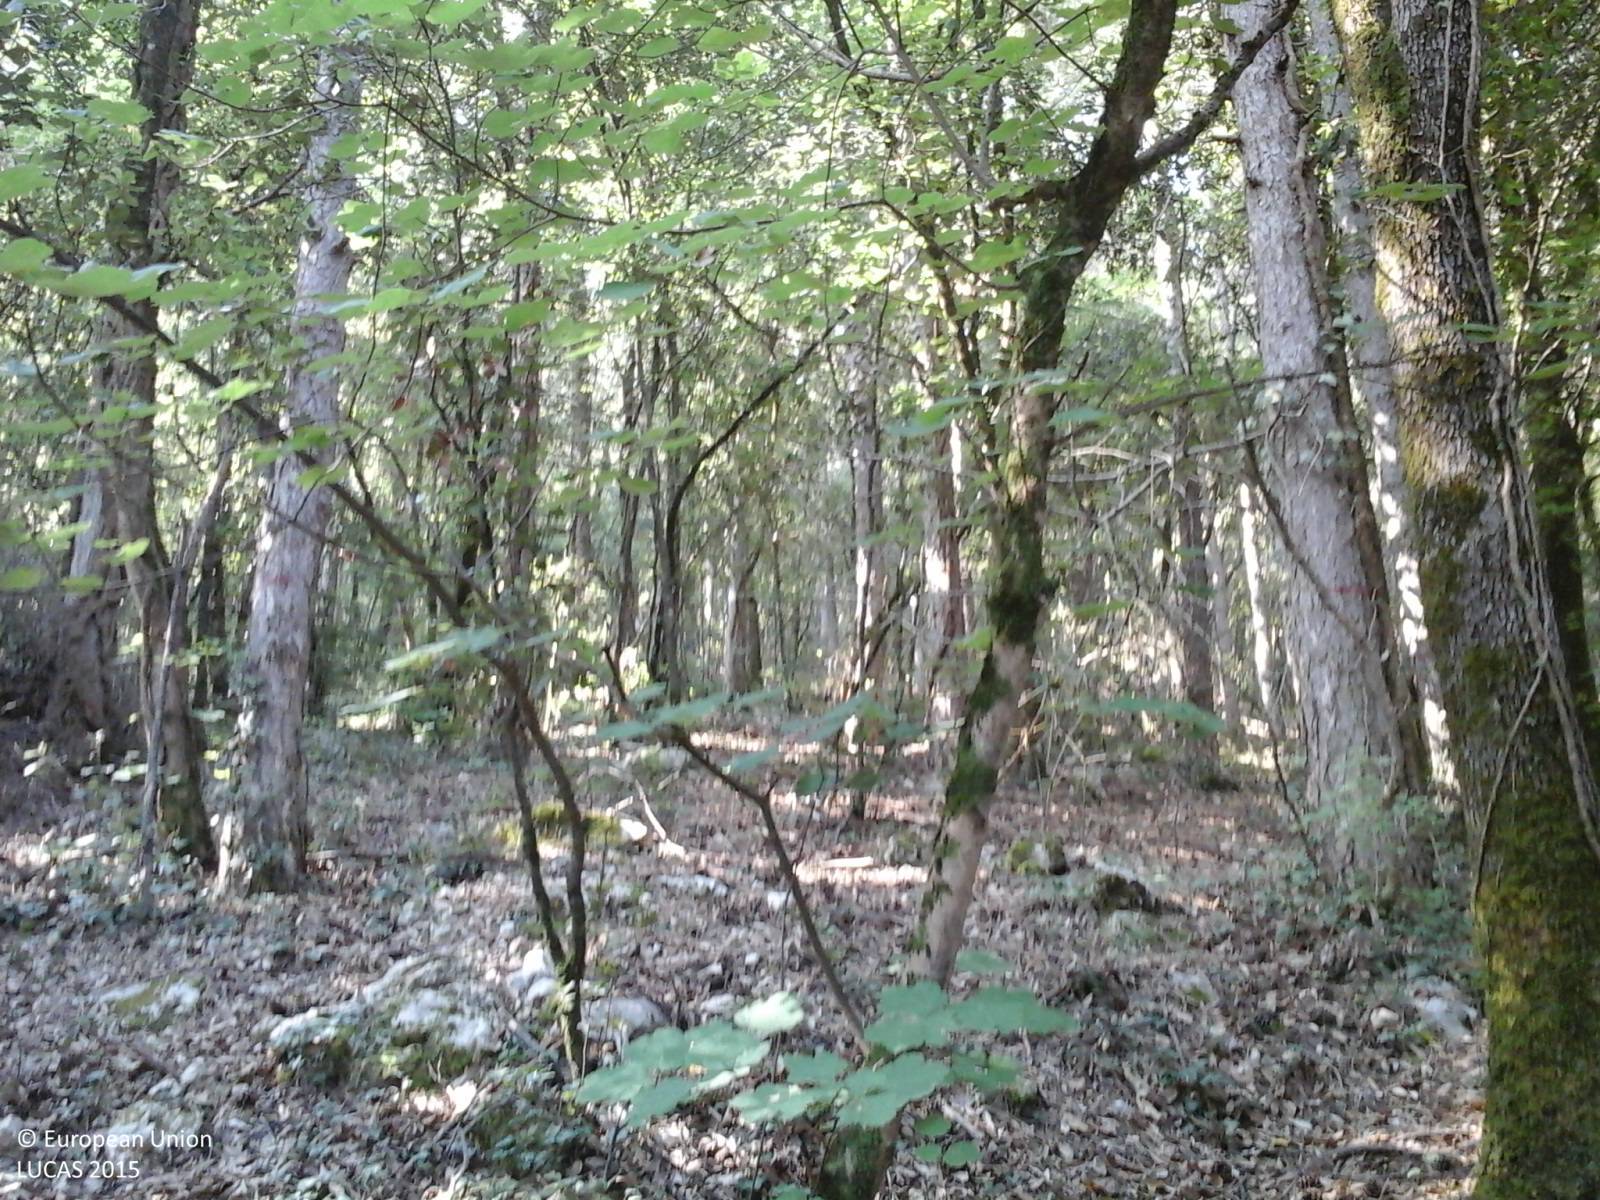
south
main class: Woodland
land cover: Other mixed woodland
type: coniferous forest of the mediterranean region
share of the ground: > 75 %
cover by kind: coniferous forest trees 60 %, broadleaved forest trees 40 %
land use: Forestry
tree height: > 5 m
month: July
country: IT
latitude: 42.3447
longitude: 13.3757
